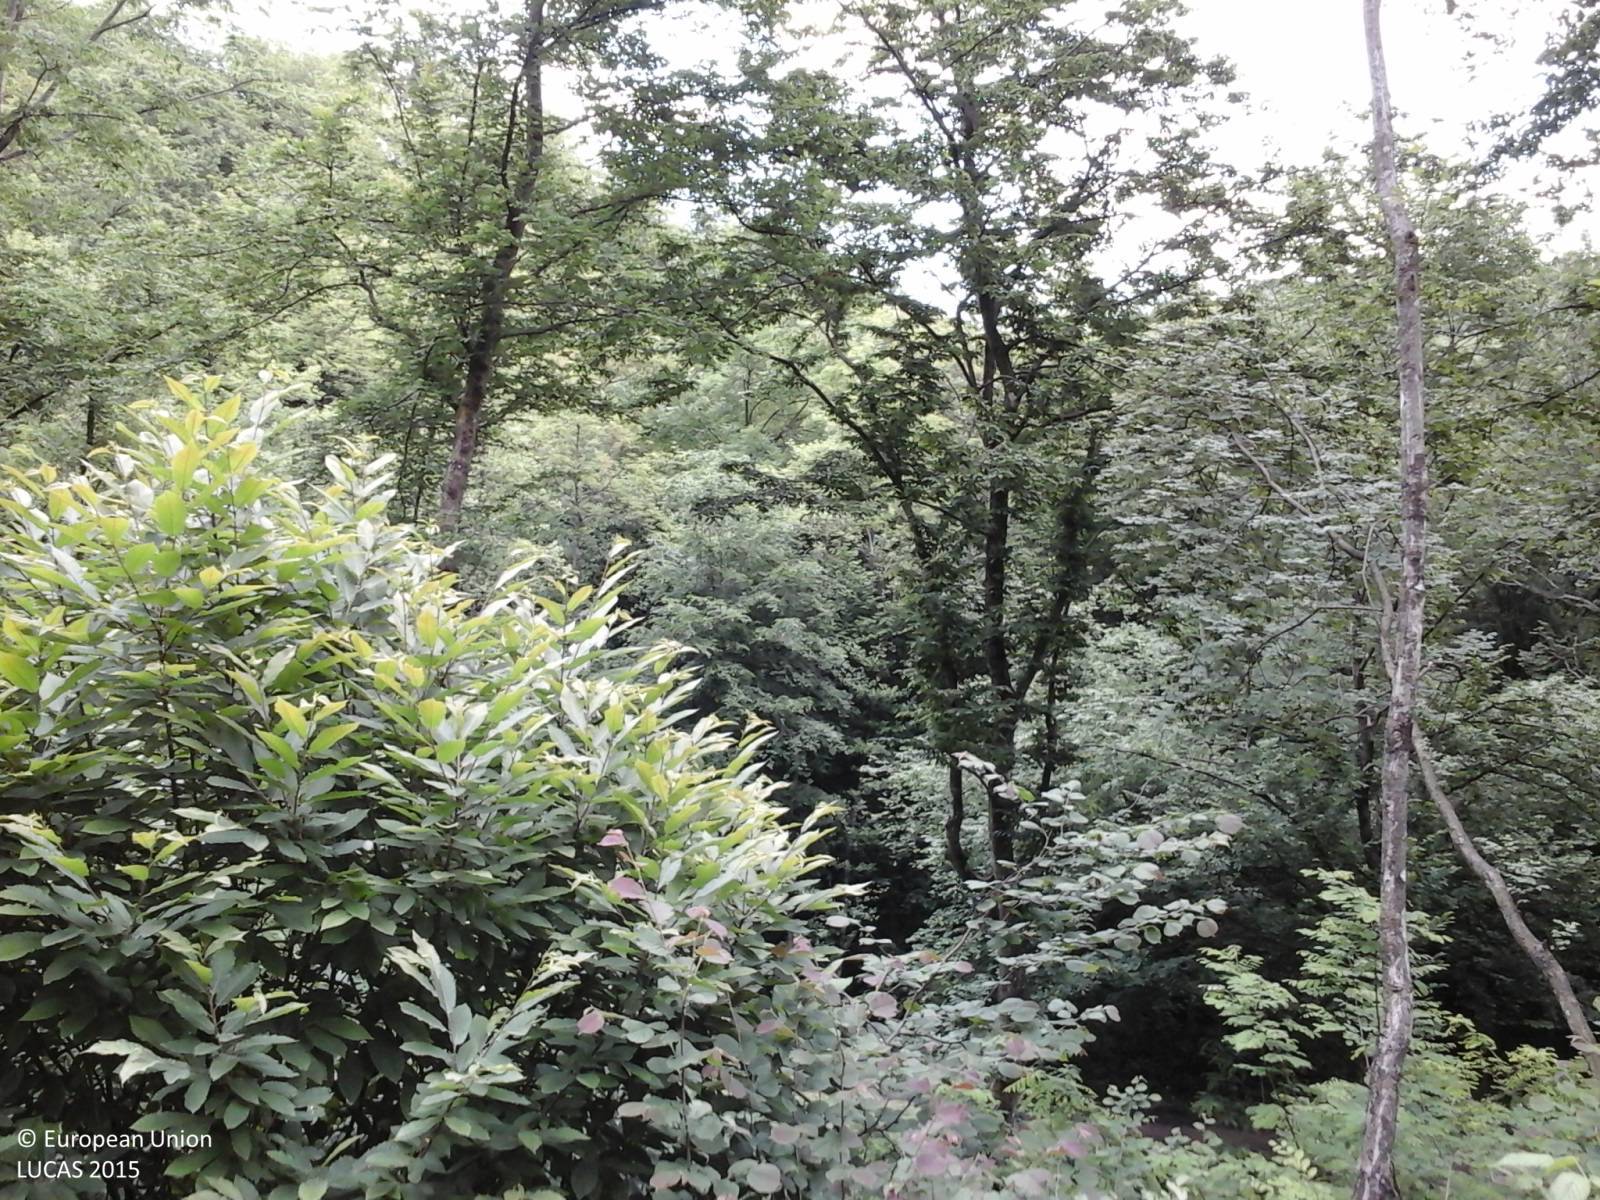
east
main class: Woodland
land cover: Broadleaved woodland
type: mesophytic deciduous forest
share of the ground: > 75 %
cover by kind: broadleaved forest trees 85 %, shrubs 10 %, herbaceous plants 5 %
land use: Forestry
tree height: > 5 m
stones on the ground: 25 - 50 %
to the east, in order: Broadleaved woodland; Tracks; Broadleaved woodland; Inland fresh running water; Broadleaved woodland
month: May
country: IT
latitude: 46.1749
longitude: 13.2737
